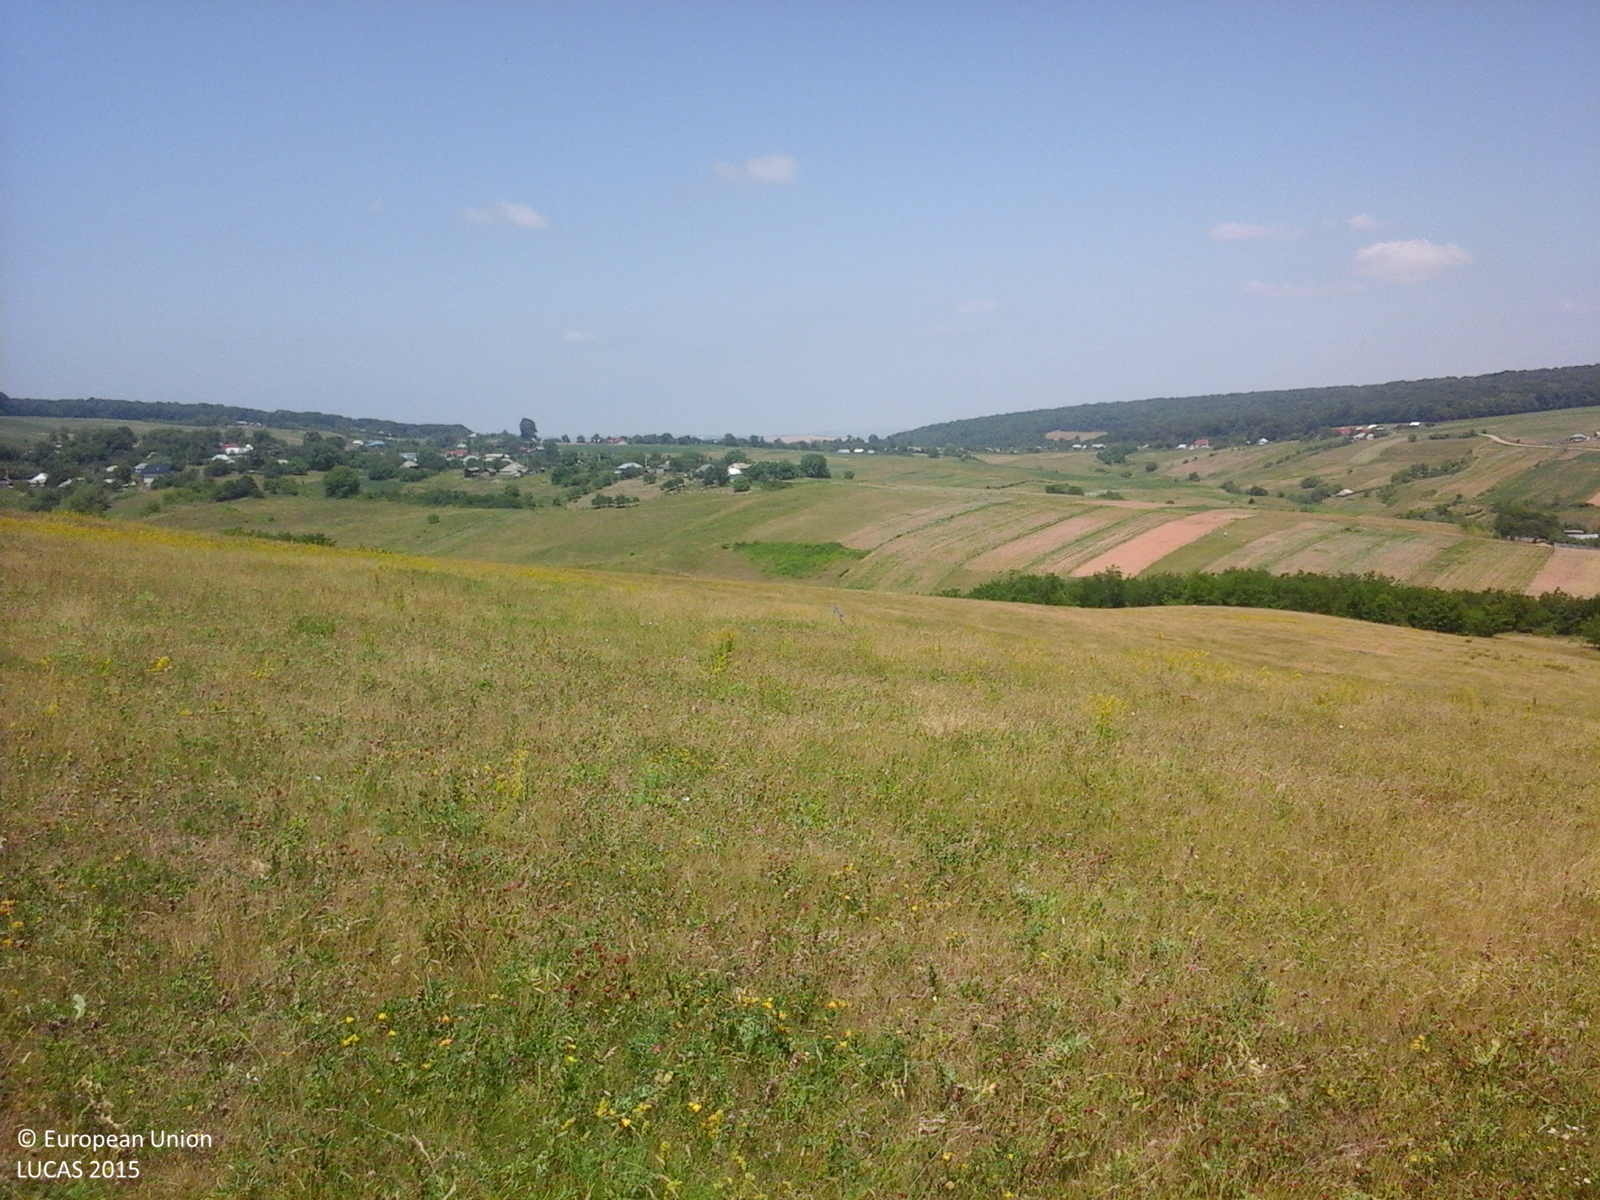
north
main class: Grassland
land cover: Grassland without tree/shrub cover
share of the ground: > 75 %
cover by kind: herbaceous plants 100 %
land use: Agriculture (excluding fallow land and kitchen gardens)
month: June
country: RO
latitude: 46.7365
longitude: 27.1546
